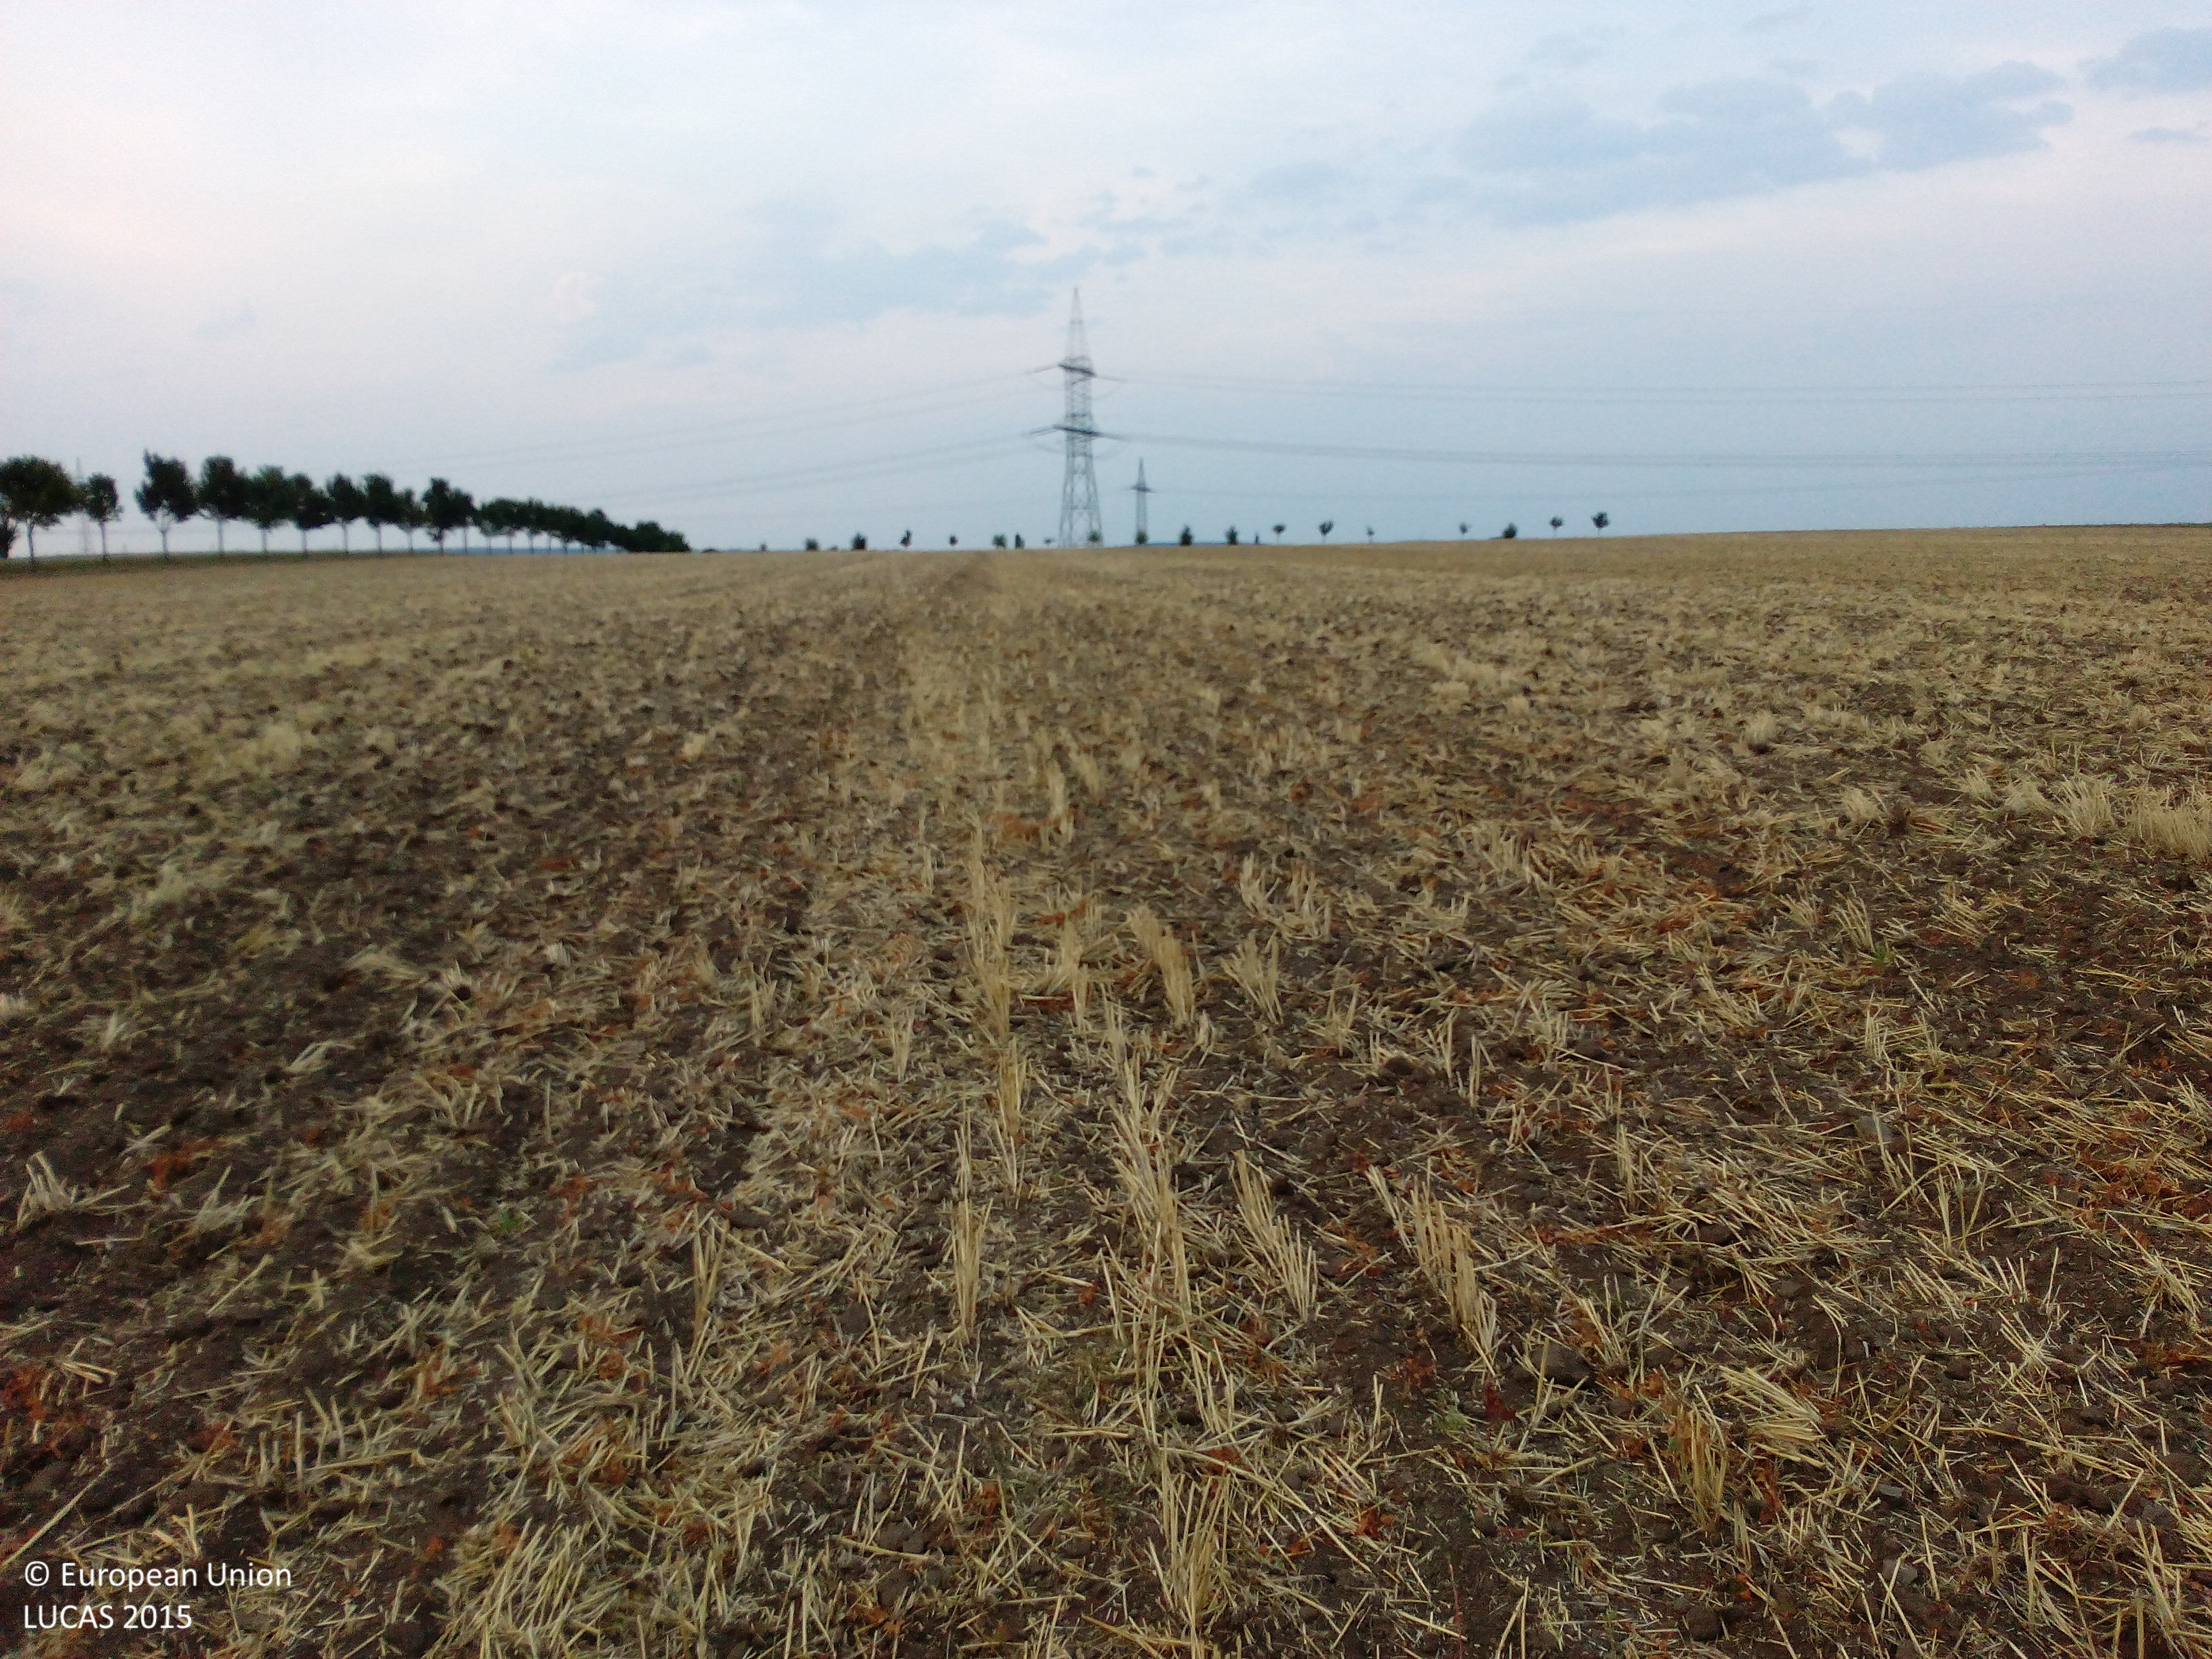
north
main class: Cropland
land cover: Common wheat
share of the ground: < 10 %
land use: Agriculture (excluding fallow land and kitchen gardens)
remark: Harvested field
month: August
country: DE
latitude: 50.9543
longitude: 10.8397
